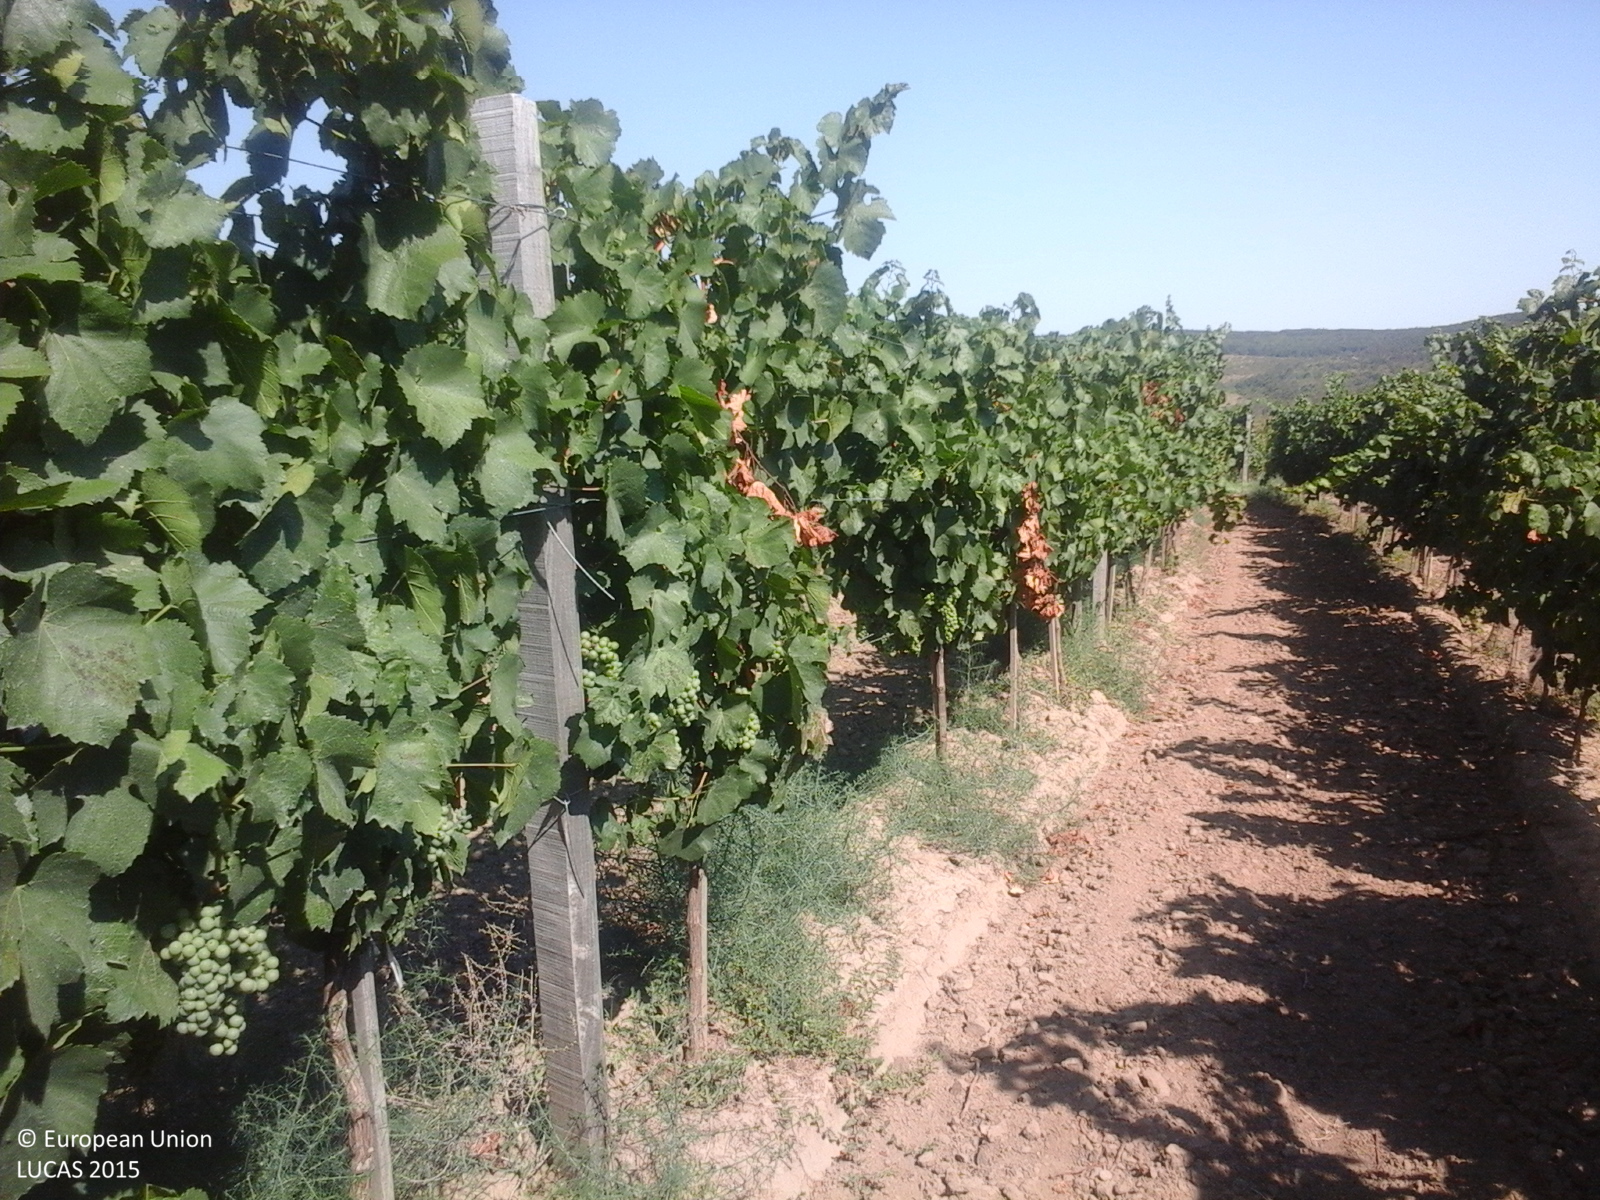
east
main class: Cropland
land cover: Vineyards
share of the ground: 50 - 75 %
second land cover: Other bare soil
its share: > 75 %
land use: Agriculture (excluding fallow land and kitchen gardens)
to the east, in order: Vineyards; Other bare soil; Tracks; Vineyards; Grass margins; Vineyards
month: August
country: RO
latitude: 44.5114
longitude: 28.2162
